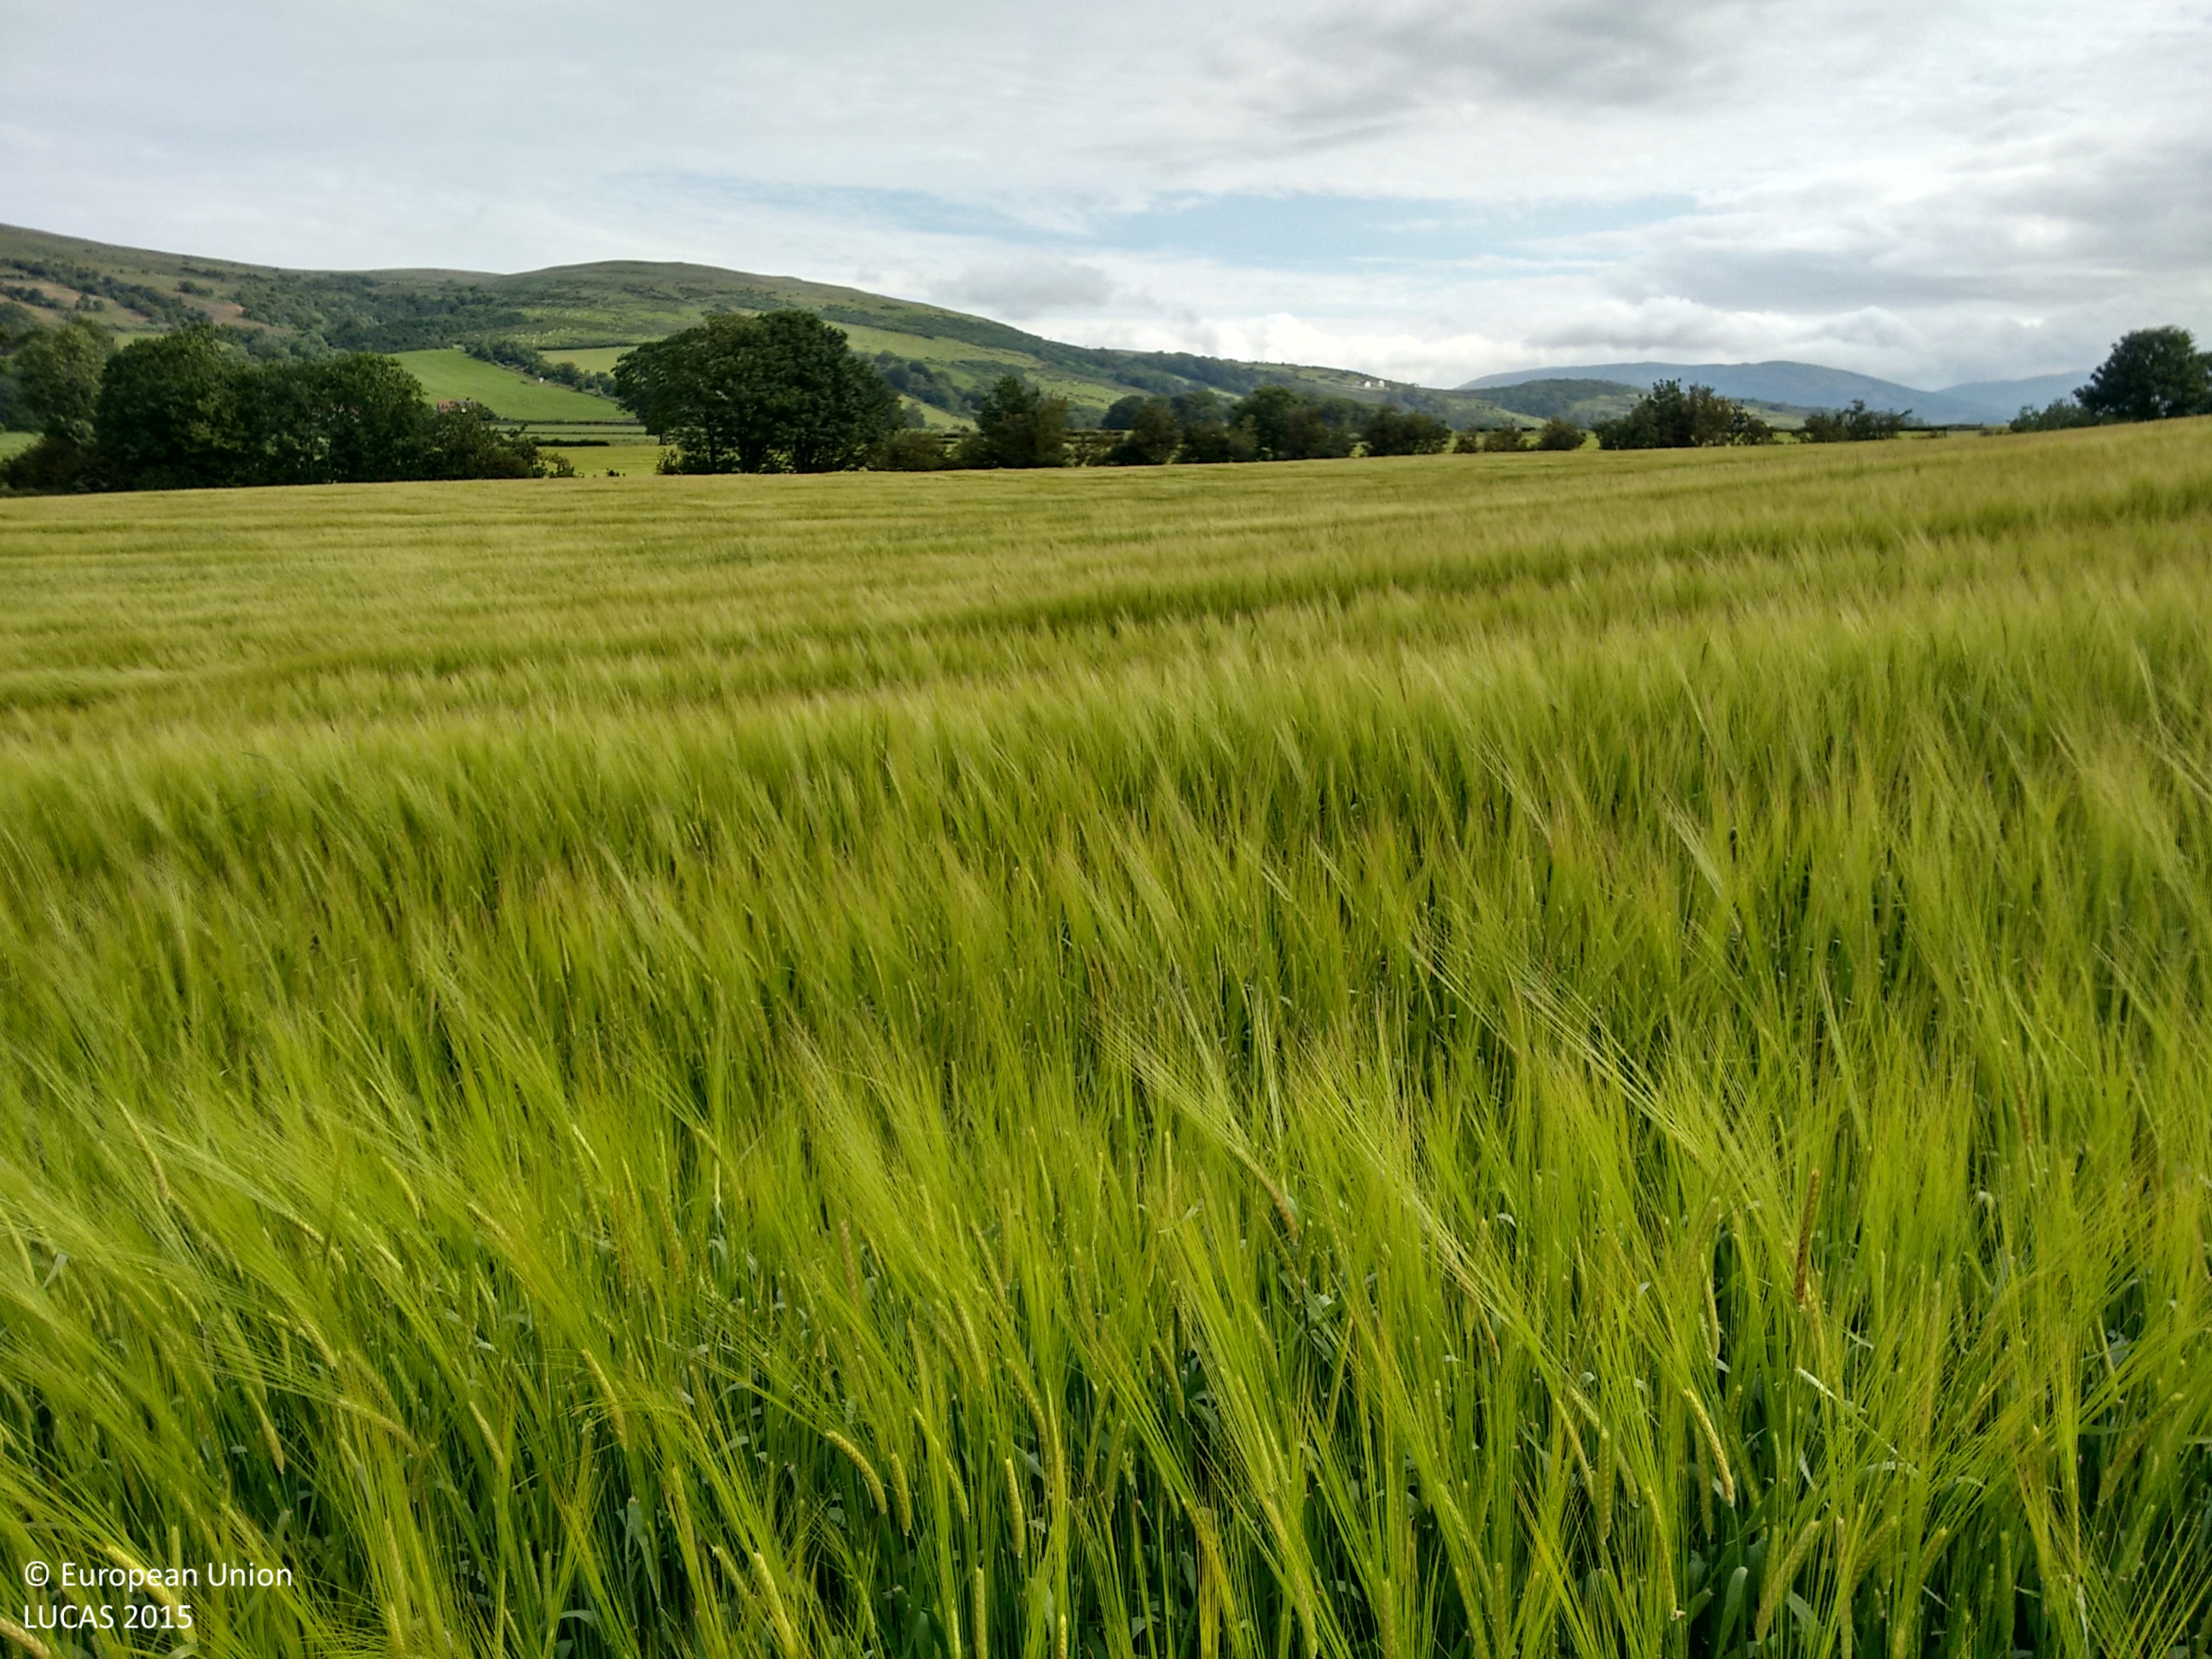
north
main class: Cropland
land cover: Barley
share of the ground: > 75 %
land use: Agriculture (excluding fallow land and kitchen gardens)
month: July
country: GB
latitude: 55.8534
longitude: -5.1130
